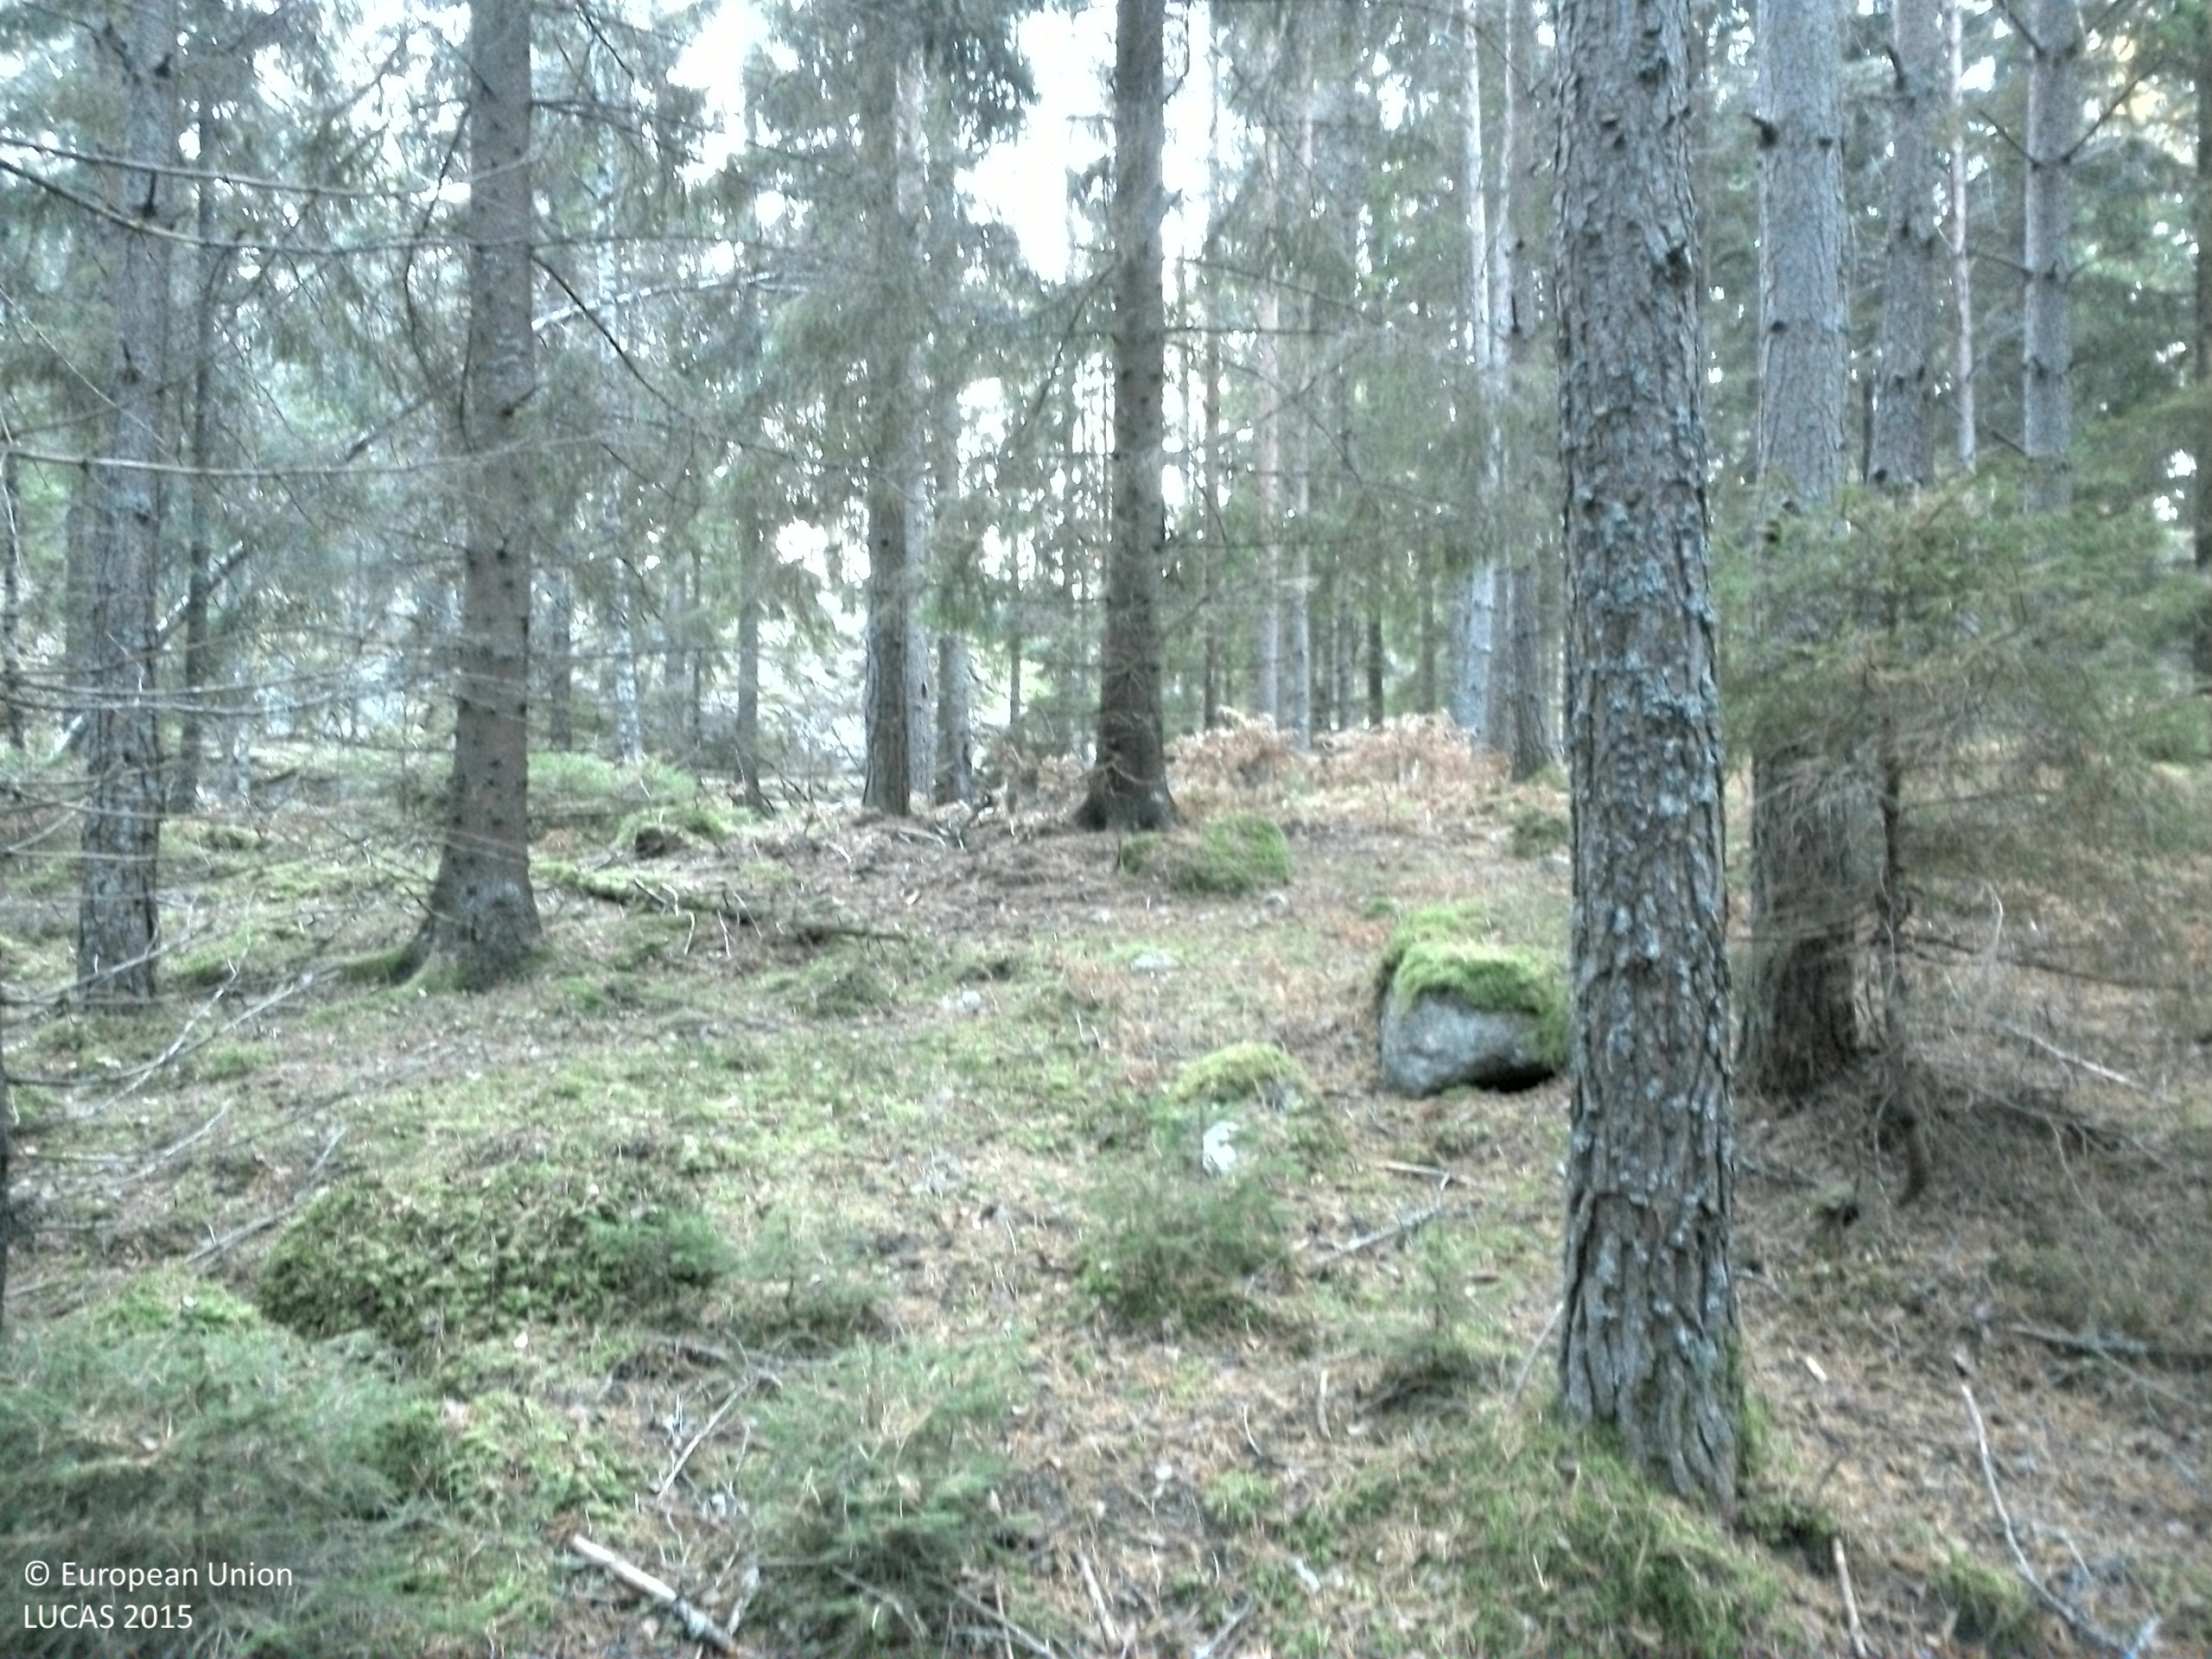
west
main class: Woodland
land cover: Pine dominated coniferous woodland
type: boreal forest
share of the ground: > 75 %
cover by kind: coniferous forest trees 75 %, shrubs 15 %, lichens and mosses 5 %, consolidated bare surface 5 %
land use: Forestry
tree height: > 5 m
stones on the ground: 10 - 25 %
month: November
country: SE
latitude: 58.9295
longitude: 16.8575
